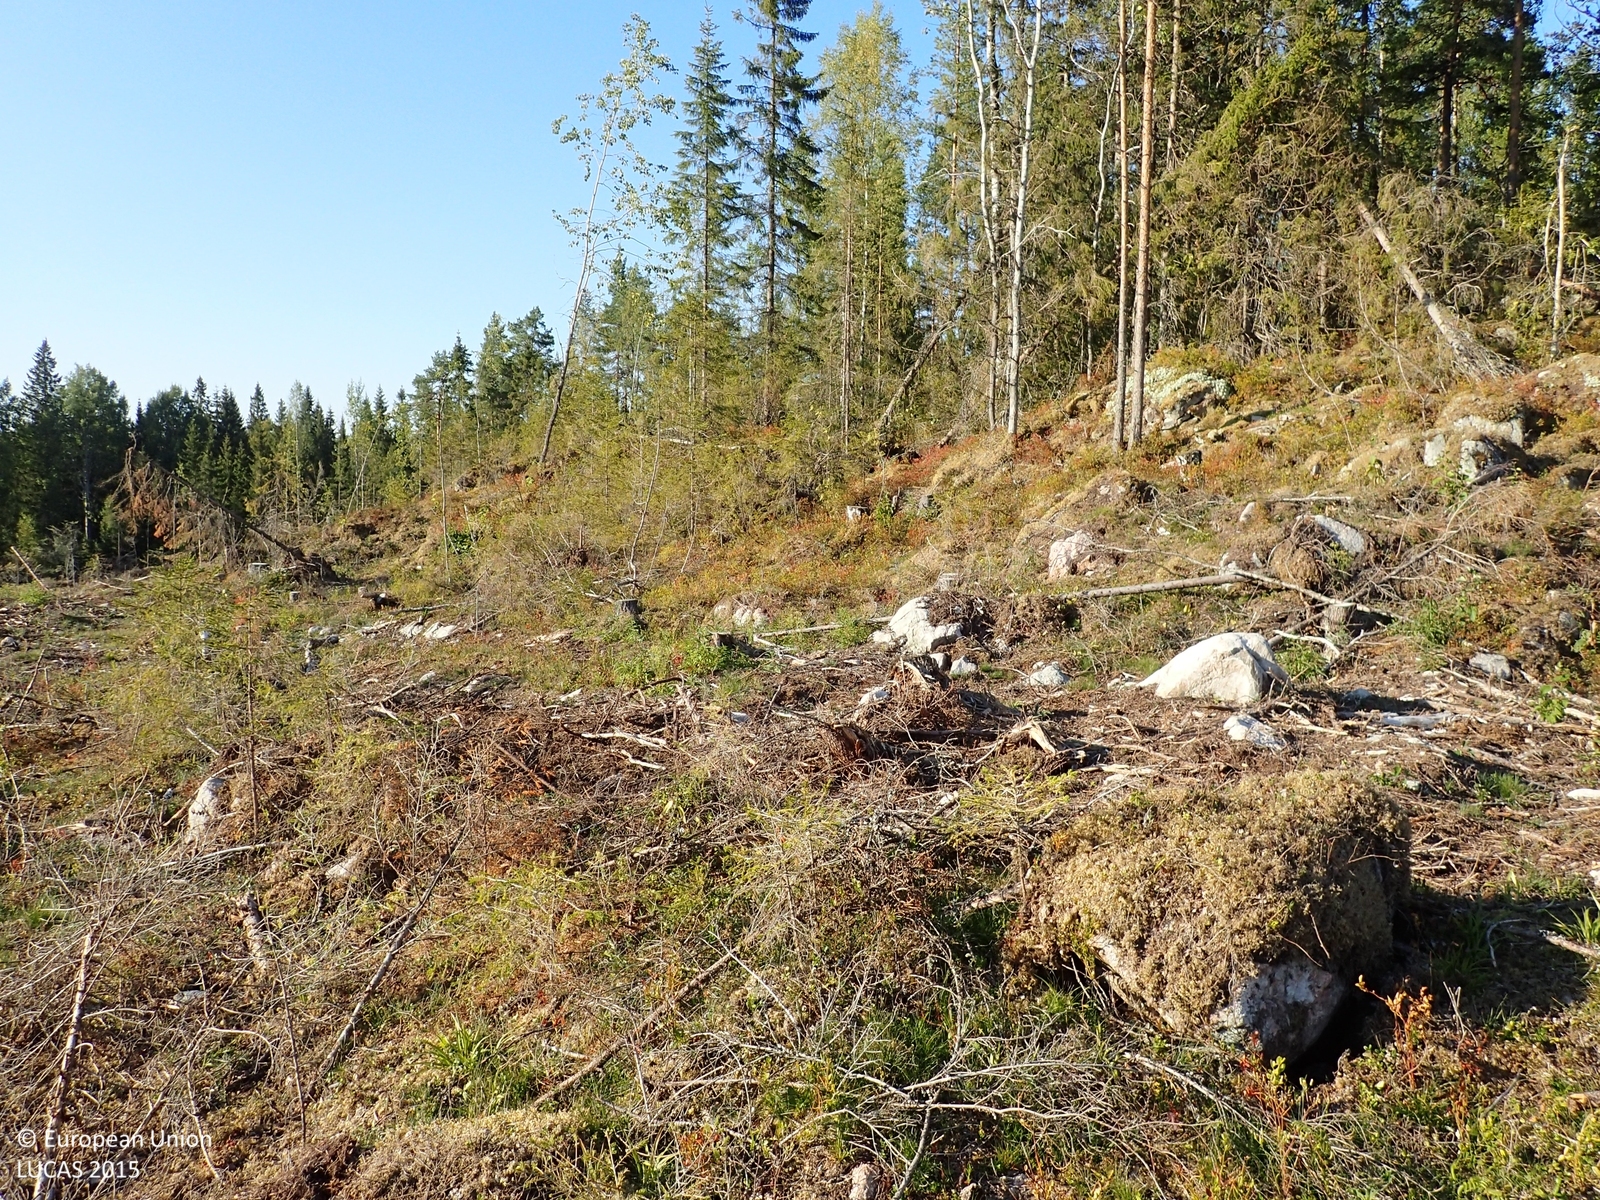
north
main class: Shrubland
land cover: Shrubland with sparse tree cover
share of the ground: 10 - 25 %
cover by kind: unconsolidated bare surface 40 %, lichens and mosses 20 %, shrubs 15 %, herbaceous plants 15 %, coniferous forest trees 5 %, consolidated bare surface 5 %
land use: Forestry
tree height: < 5 m
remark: Clear cut
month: August
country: FI
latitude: 62.4324
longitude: 21.8826
